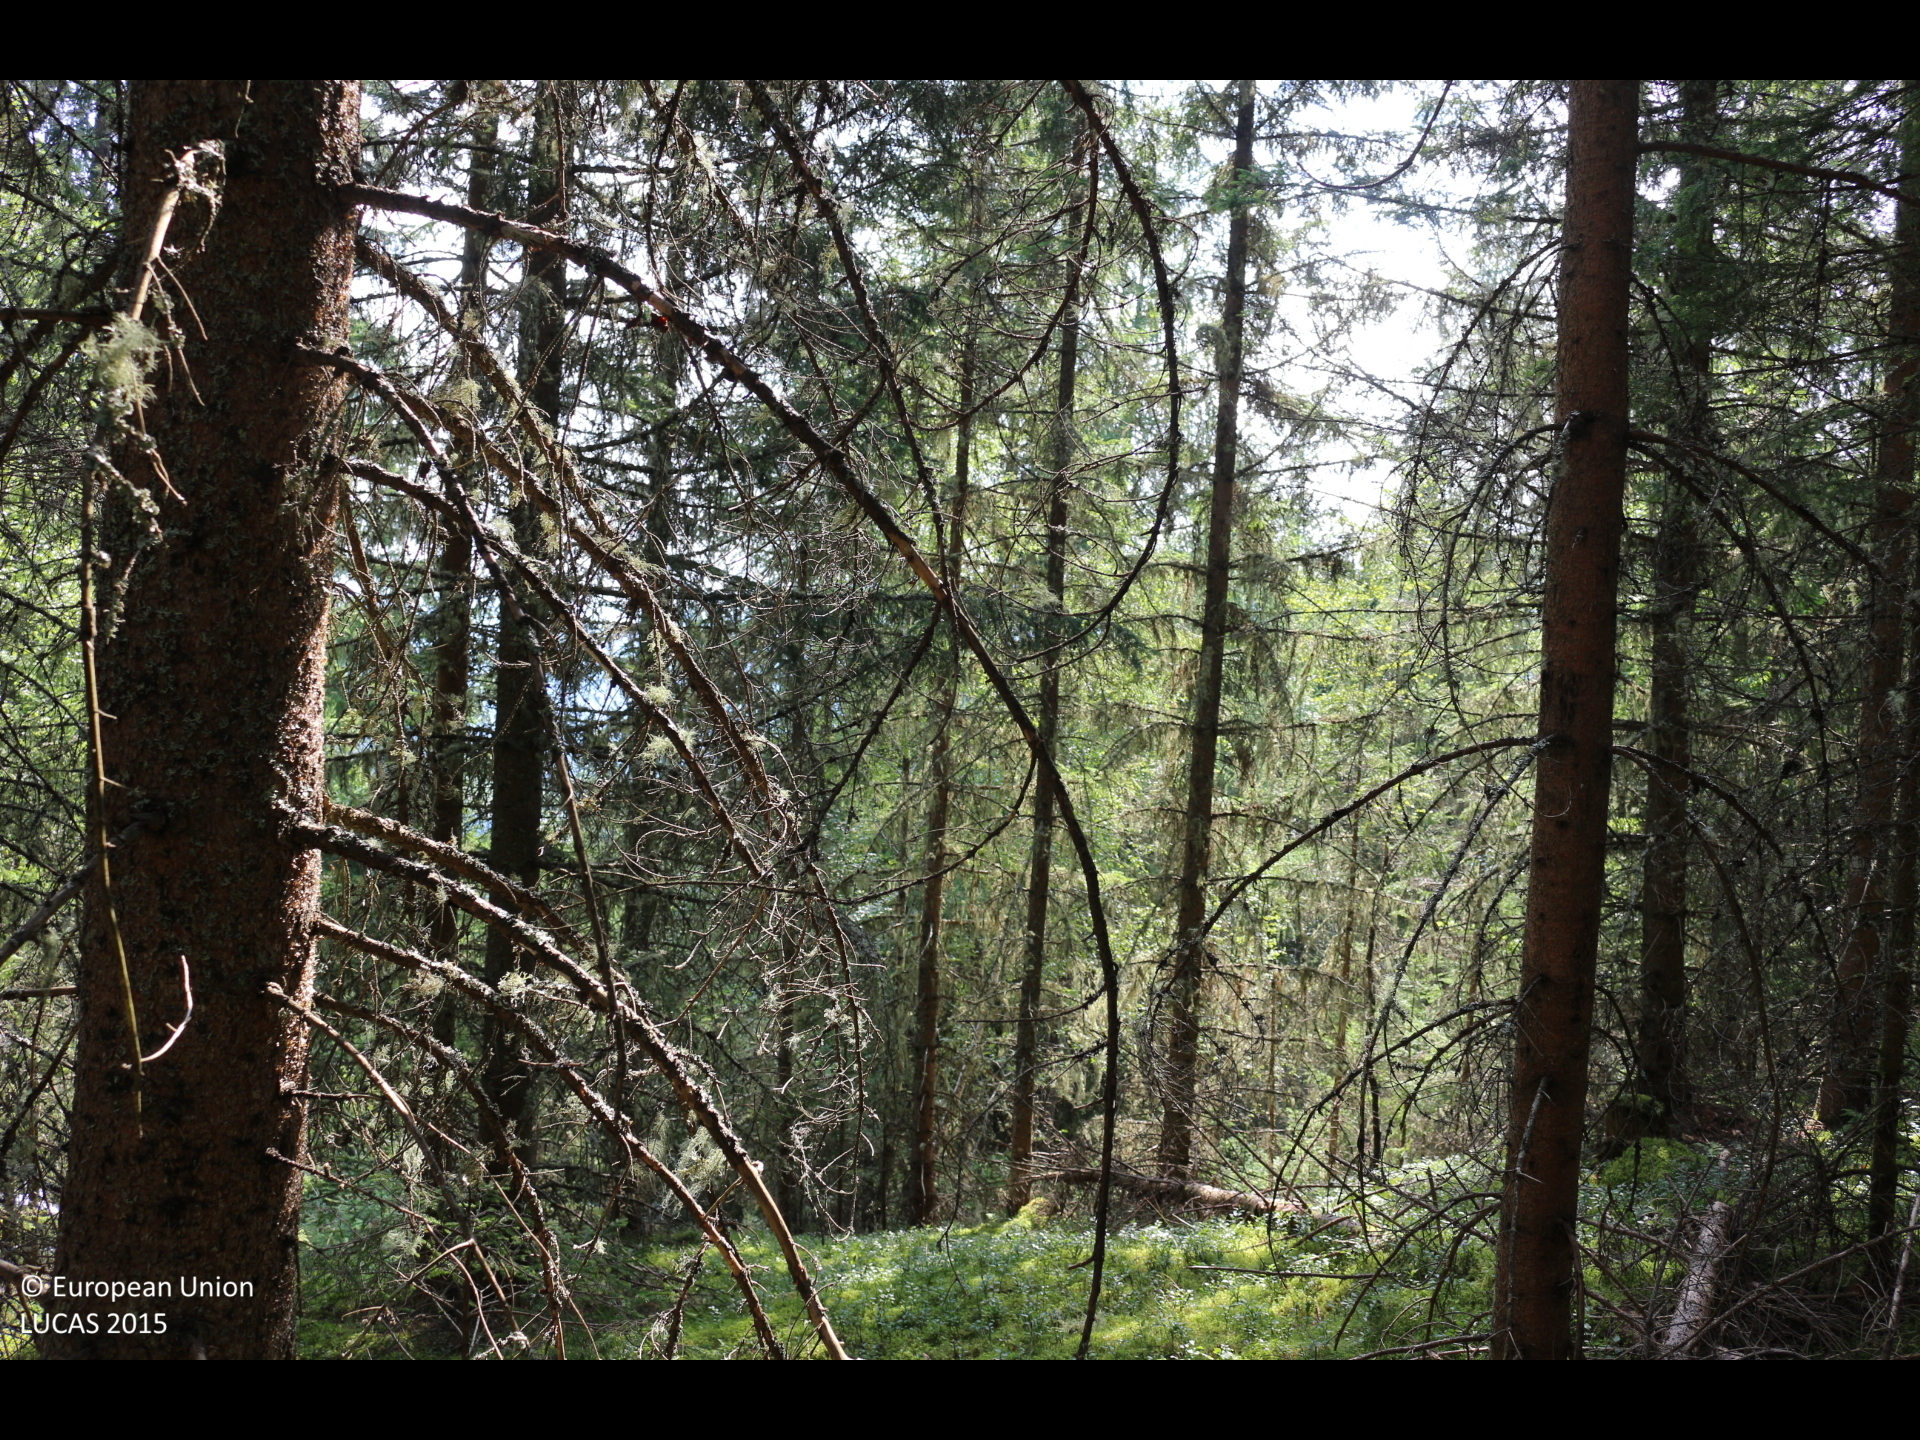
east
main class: Woodland
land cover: Spruce dominated coniferous woodland
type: alpine coniferous forest
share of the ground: > 75 %
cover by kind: coniferous forest trees 90 %, lichens and mosses 10 %
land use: Forestry
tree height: > 5 m
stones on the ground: < 10 %
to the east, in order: Spruce dominated coniferous woodland; Tracks; Spruce dominated coniferous woodland; Tracks; Spruce dominated coniferous woodland; Grassland with sparse tree/shrub cover; Spruce dominated coniferous woodland; Other coniferous woodland
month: August
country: AT
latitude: 46.9744
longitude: 14.1386
